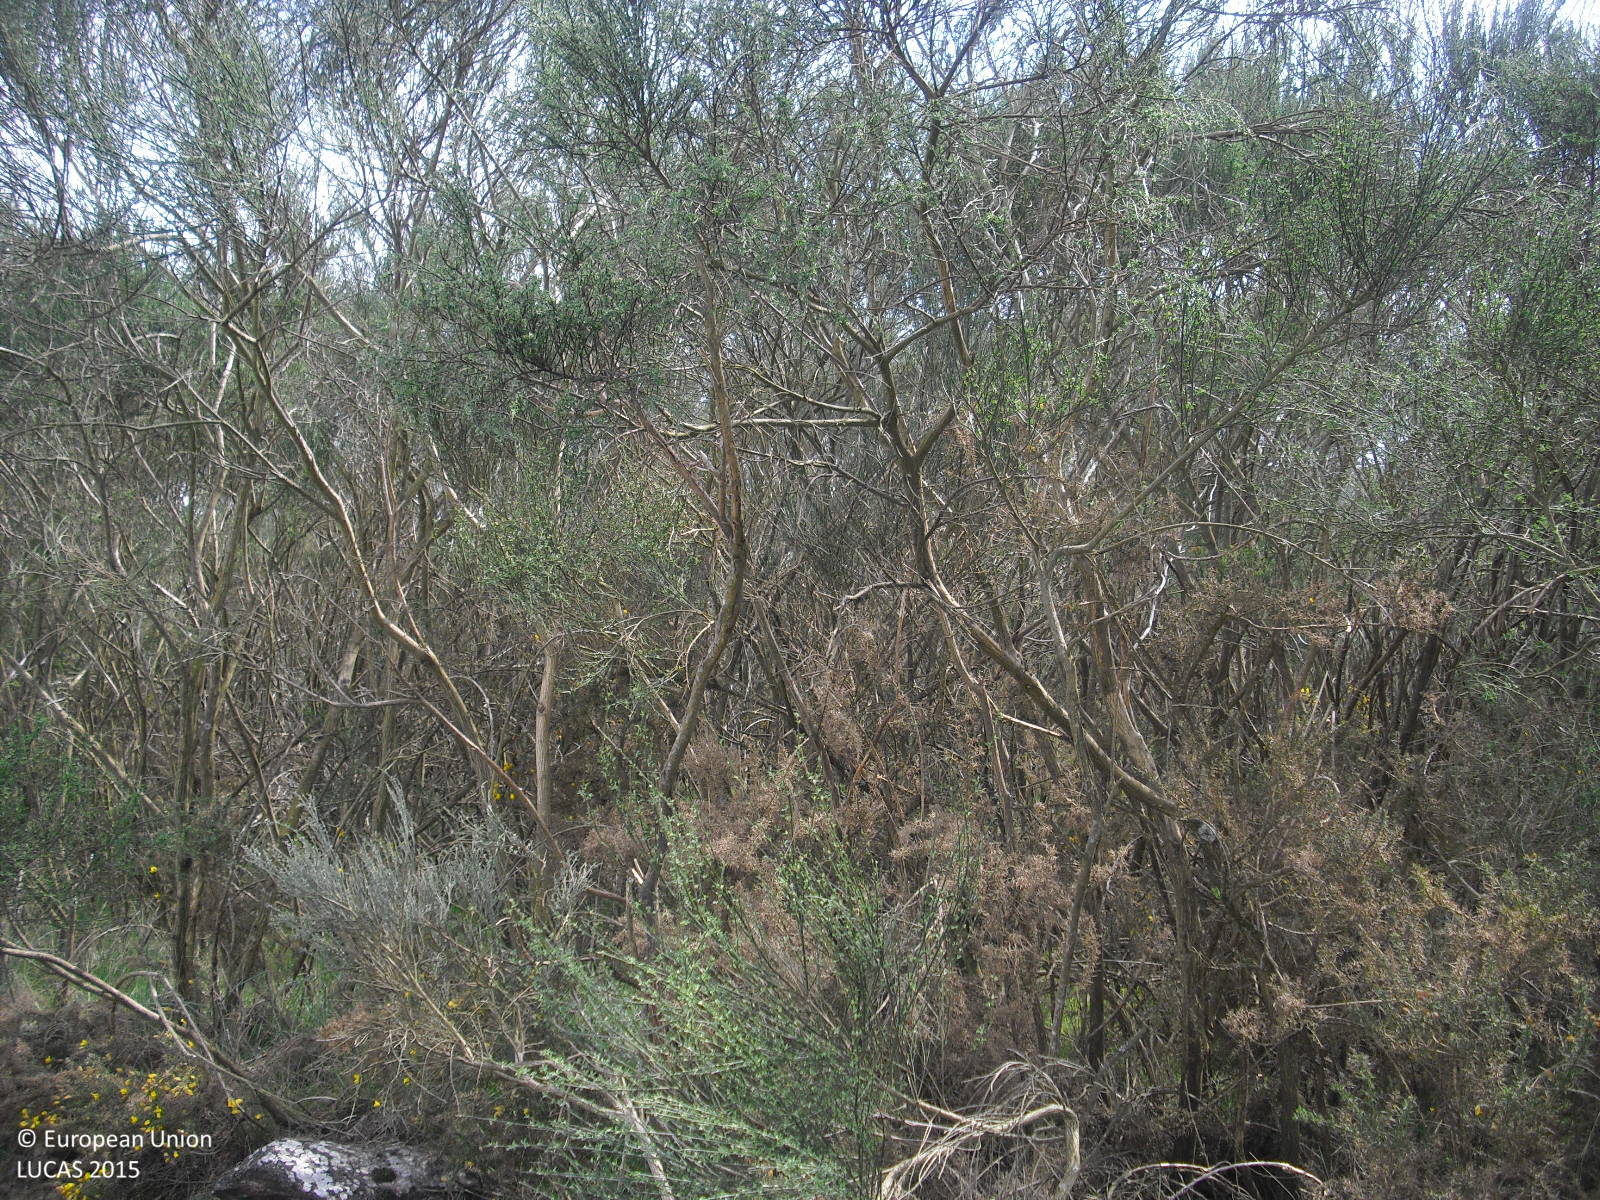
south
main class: Shrubland
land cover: Shrubland without tree cover
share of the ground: > 75 %
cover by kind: shrubs 90 %, herbaceous plants 10 %
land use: Semi-natural and natural areas not in use
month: April
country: ES
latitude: 41.9846
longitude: -7.8011
